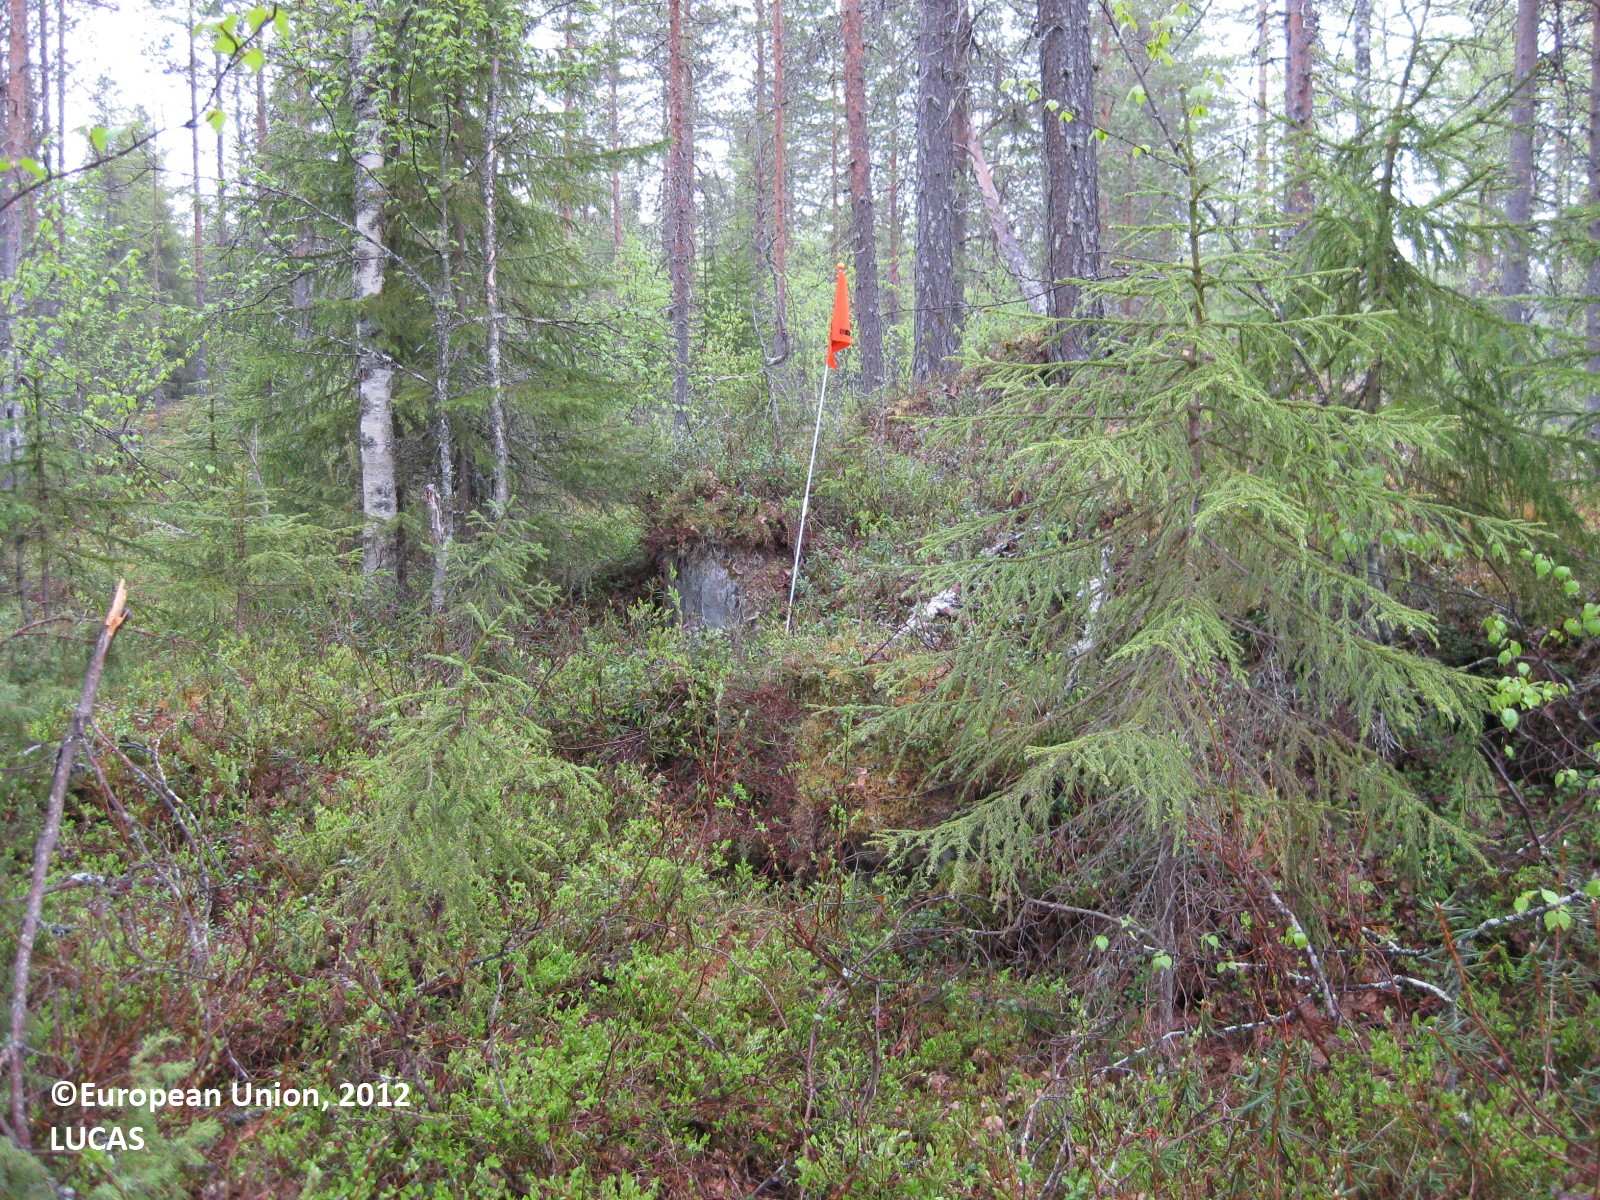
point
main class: Woodland
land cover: Other mixed woodland
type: boreal forest
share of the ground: > 75 %
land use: Forestry
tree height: > 5 m
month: June
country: FI
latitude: 65.2982
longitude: 29.2575
